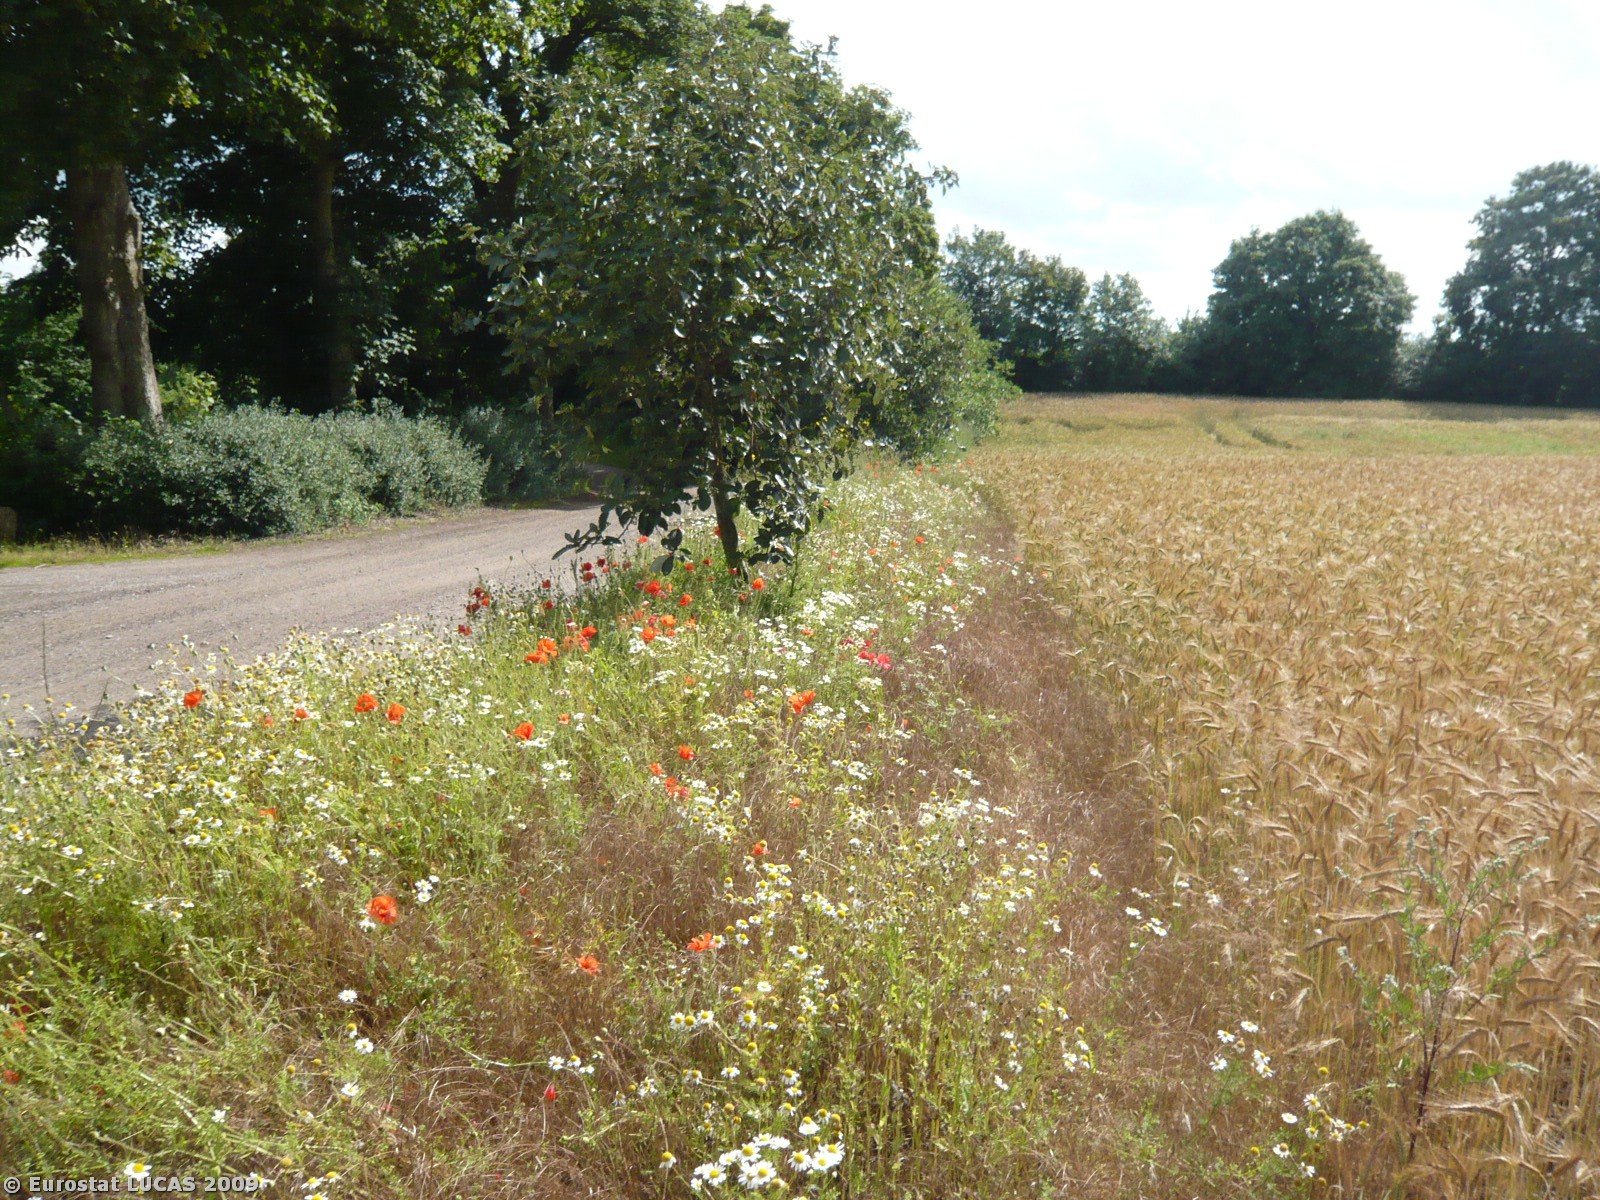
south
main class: Cropland
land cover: Barley
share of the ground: > 75 %
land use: Agriculture (excluding fallow land and kitchen gardens)
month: July
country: DK
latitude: 55.5306
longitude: 11.5987
